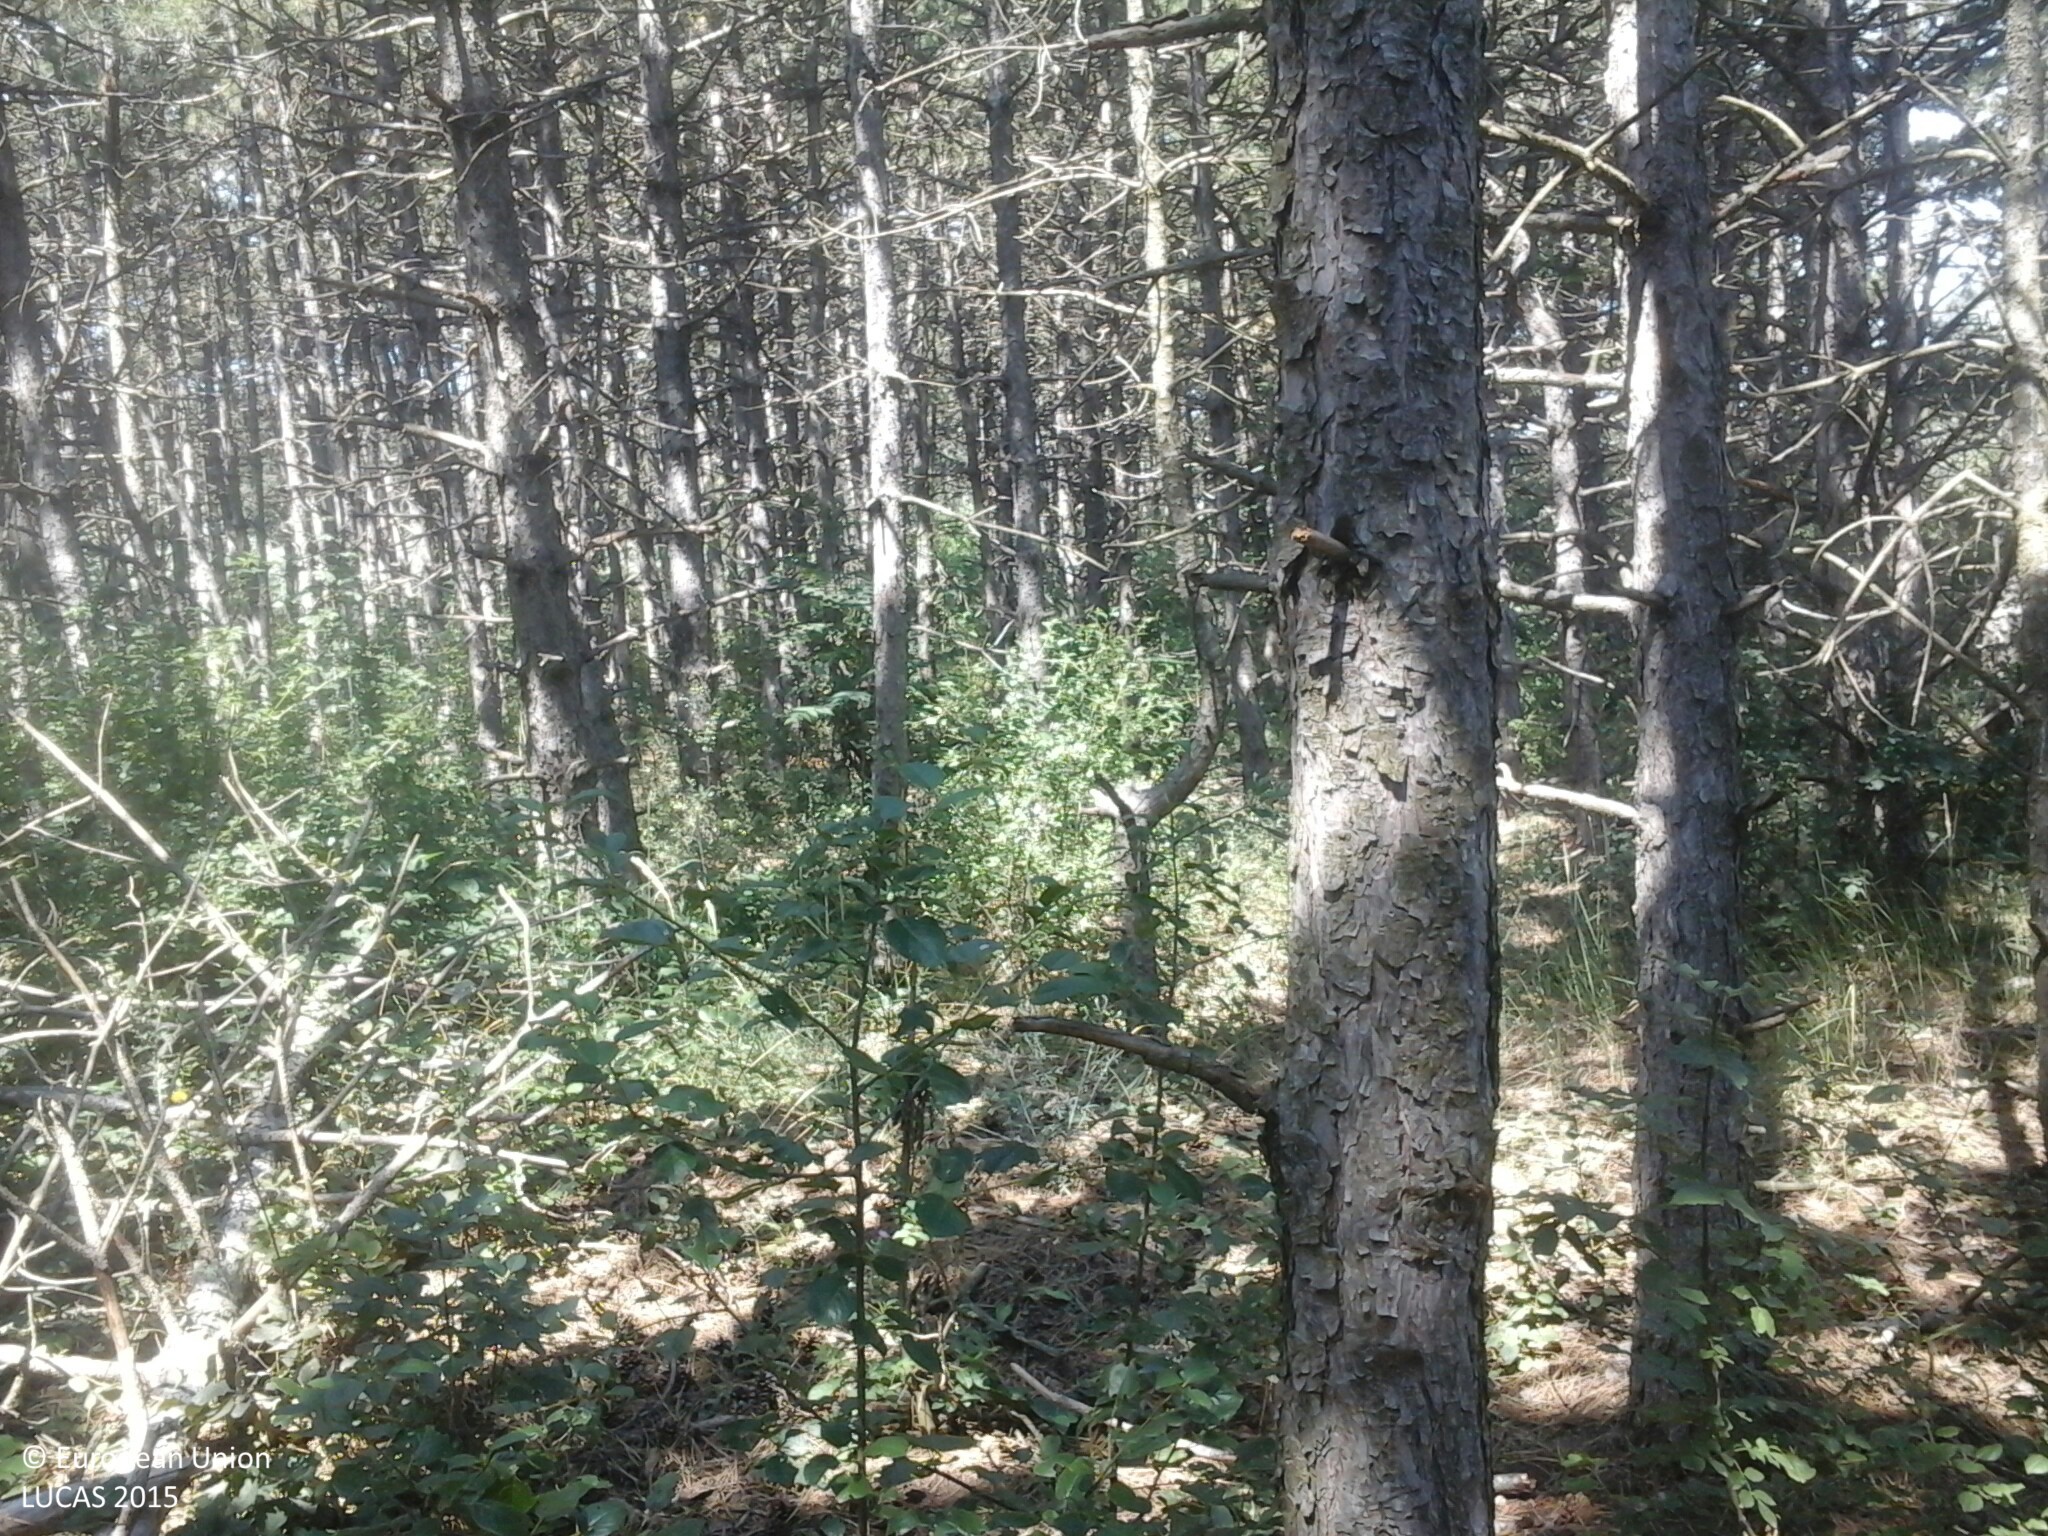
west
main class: Woodland
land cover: Other coniferous woodland
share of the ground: > 75 %
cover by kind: coniferous forest trees 70 %, shrubs 20 %, herbaceous plants 10 %
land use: Forestry
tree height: < 5 m
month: July
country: HU
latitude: 47.2154
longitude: 18.1577
